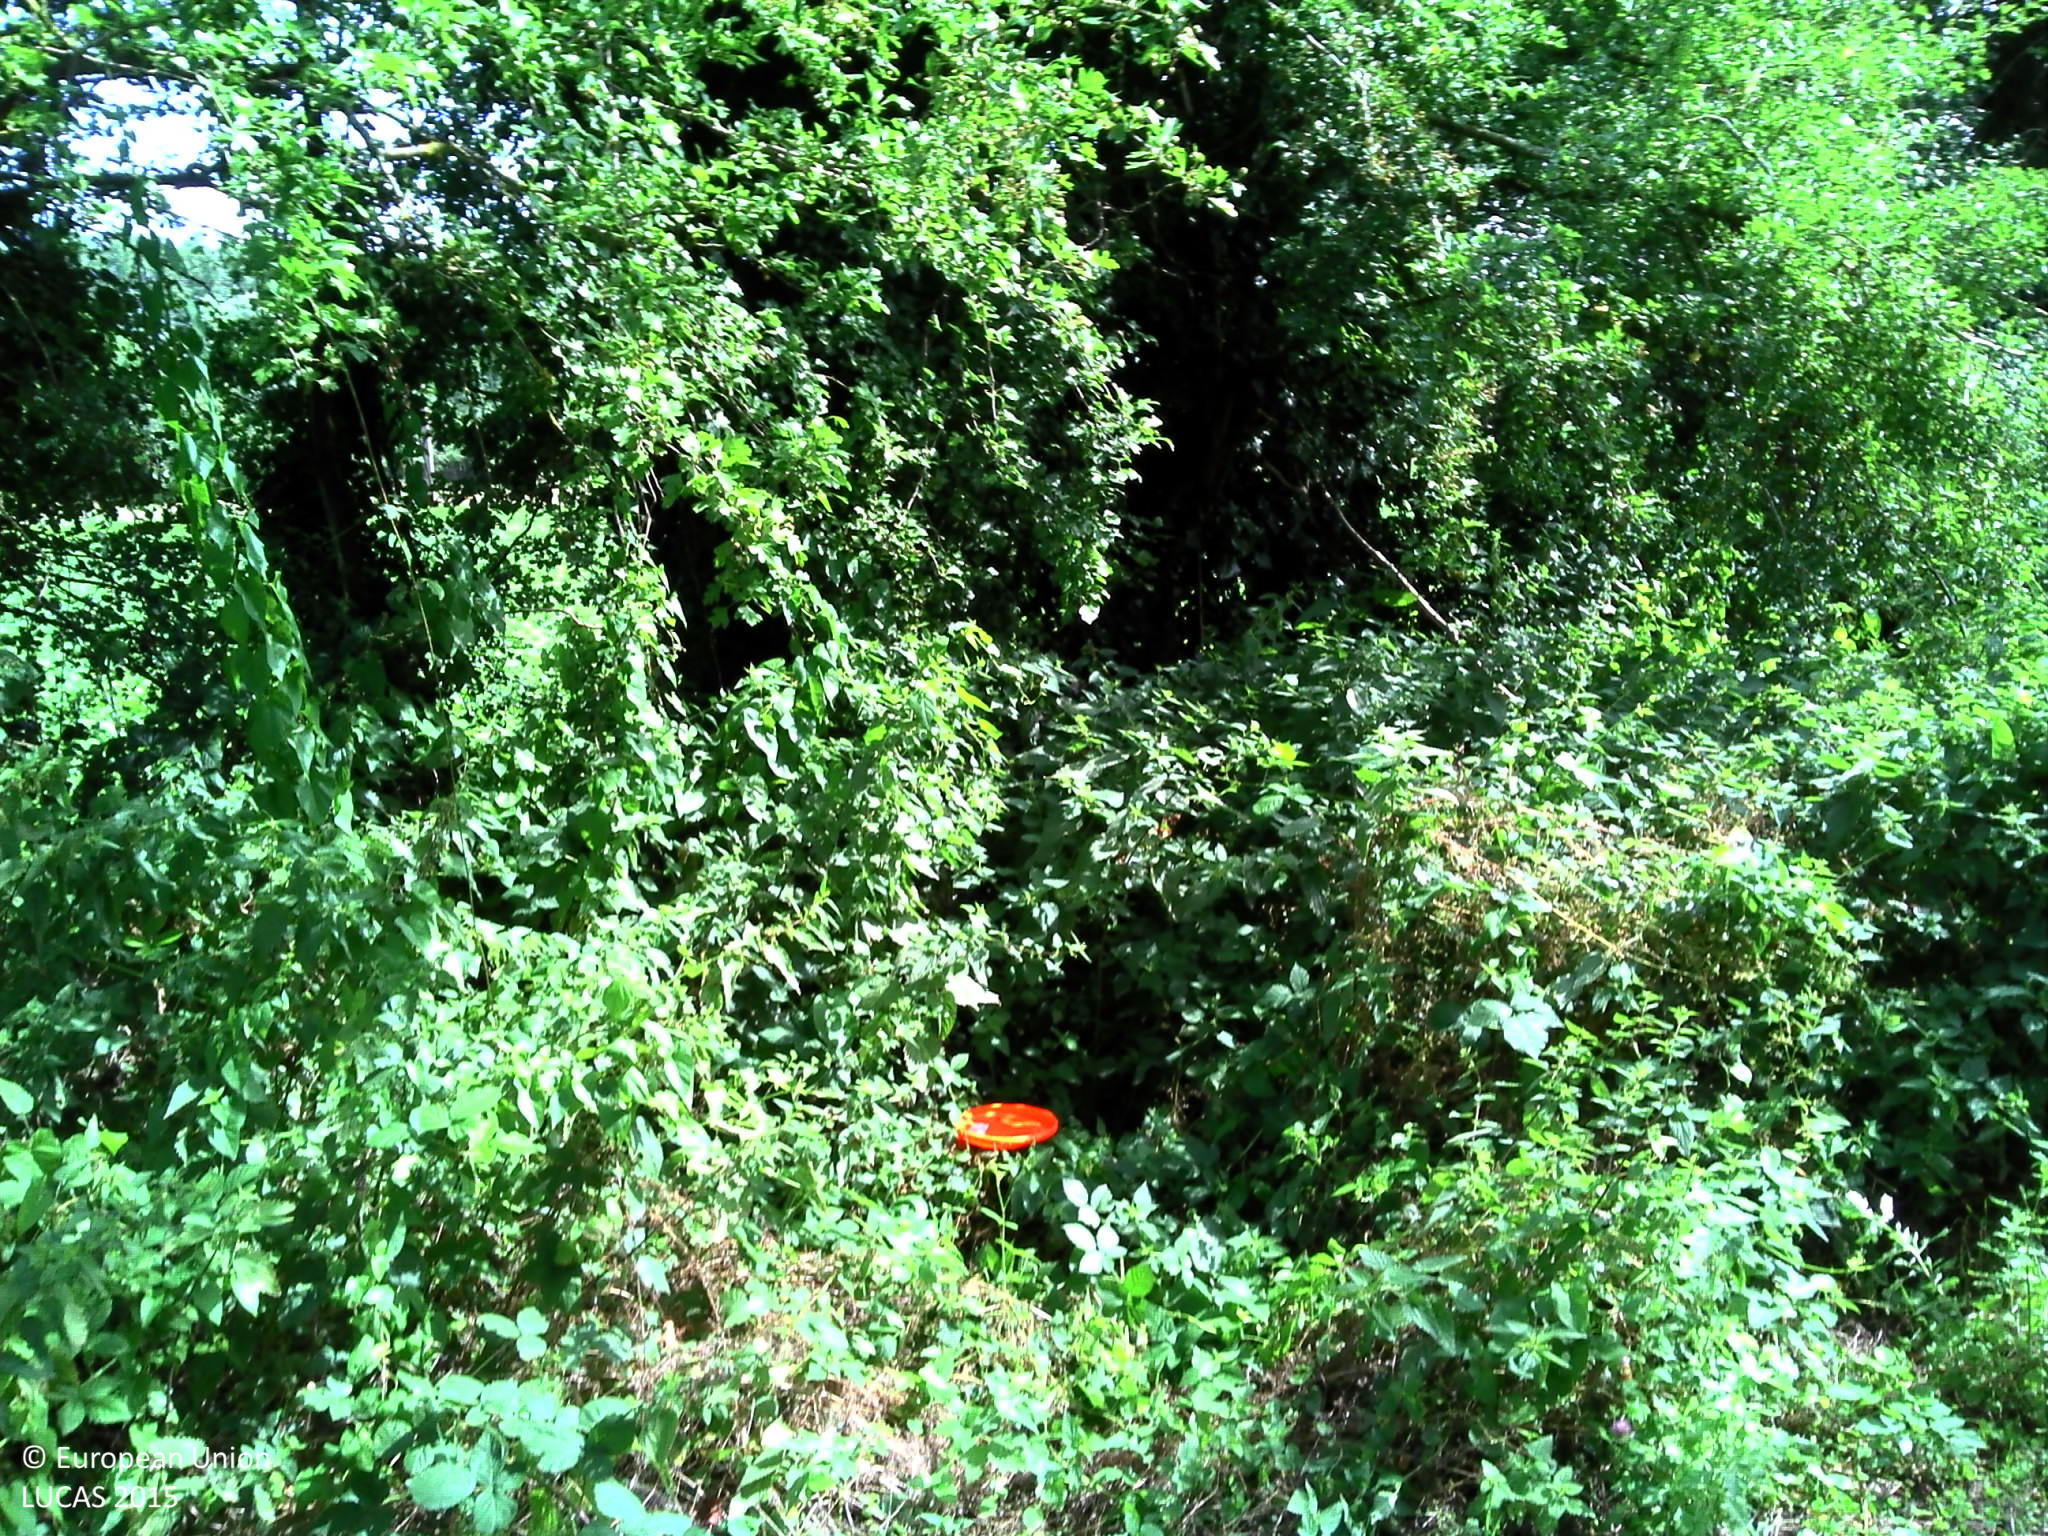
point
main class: Shrubland
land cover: Shrubland with sparse tree cover
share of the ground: > 75 %
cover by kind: shrubs 60 %, herbaceous plants 35 %, broadleaved forest trees 5 %
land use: Abandoned areas
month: July
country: BE
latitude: 50.5756
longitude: 4.1628
